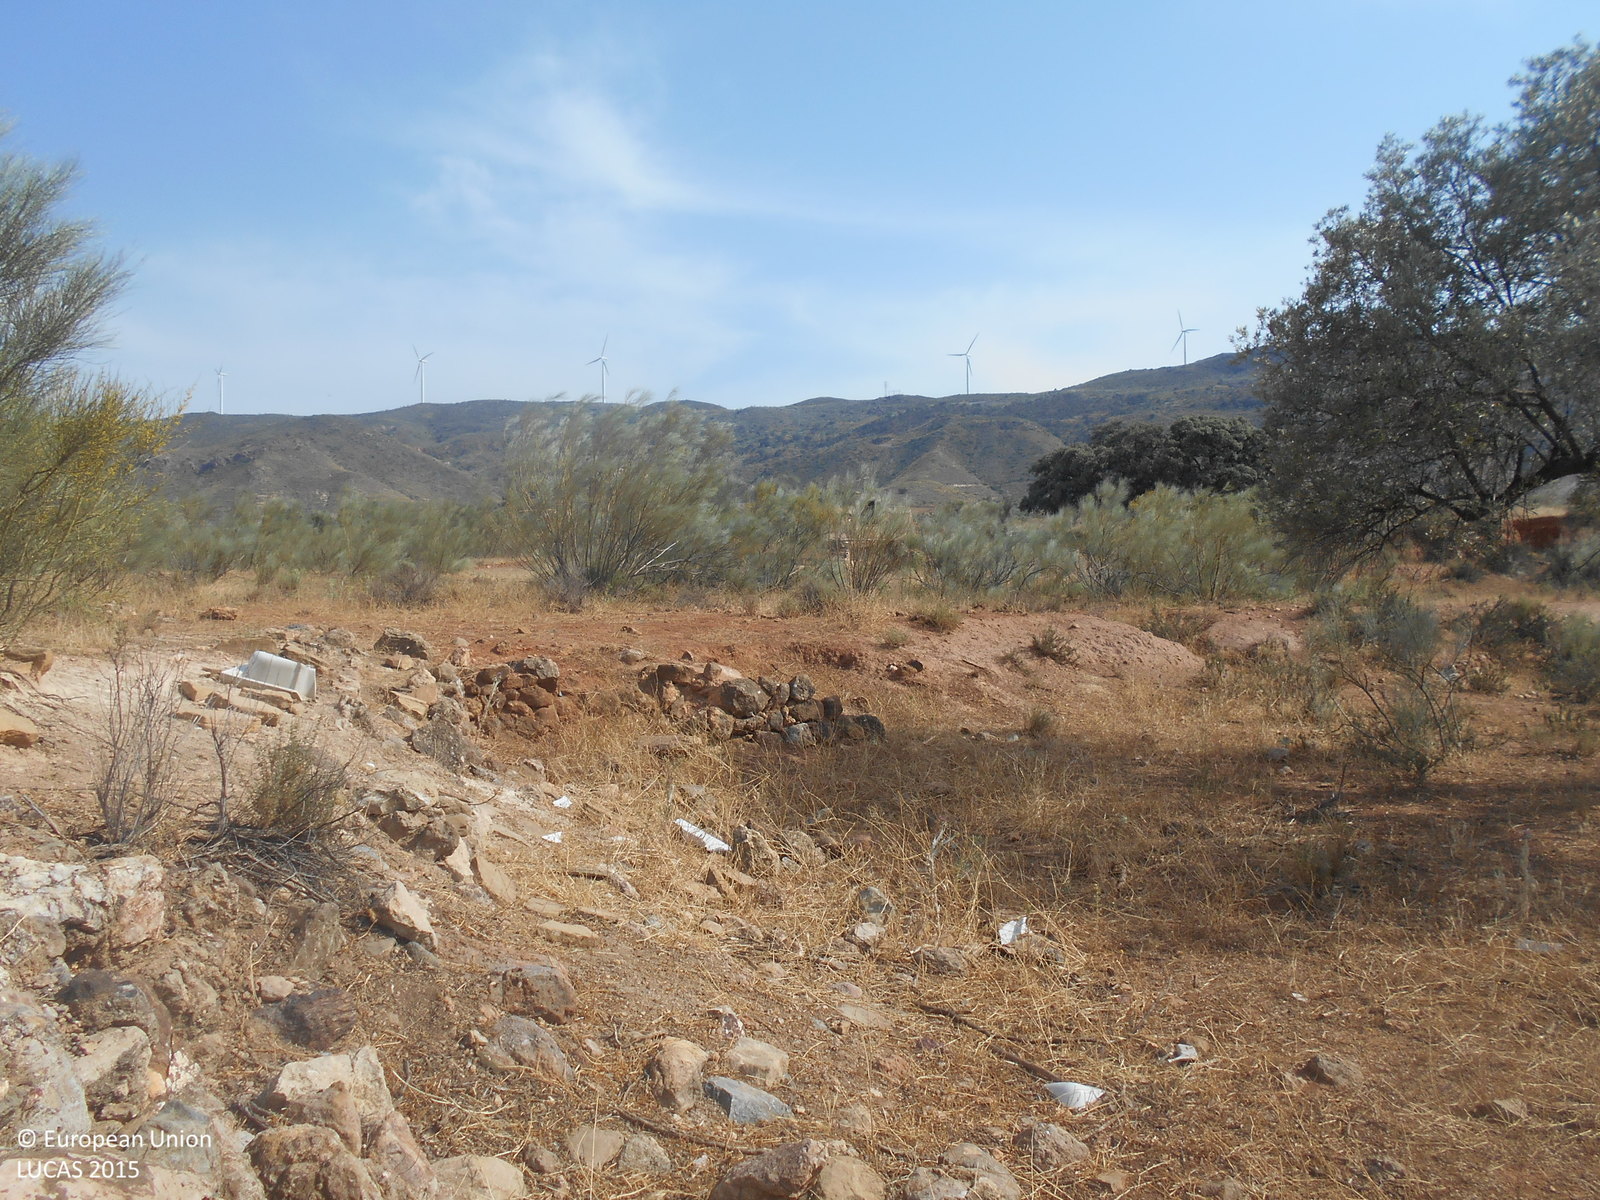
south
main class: Shrubland
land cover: Shrubland with sparse tree cover
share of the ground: 10 - 25 %
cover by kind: herbaceous plants 40 %, unconsolidated bare surface 35 %, shrubs 20 %, broadleaved forest trees 5 %
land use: Semi-natural and natural areas not in use
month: May
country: ES
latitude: 37.0448
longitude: -2.2437
